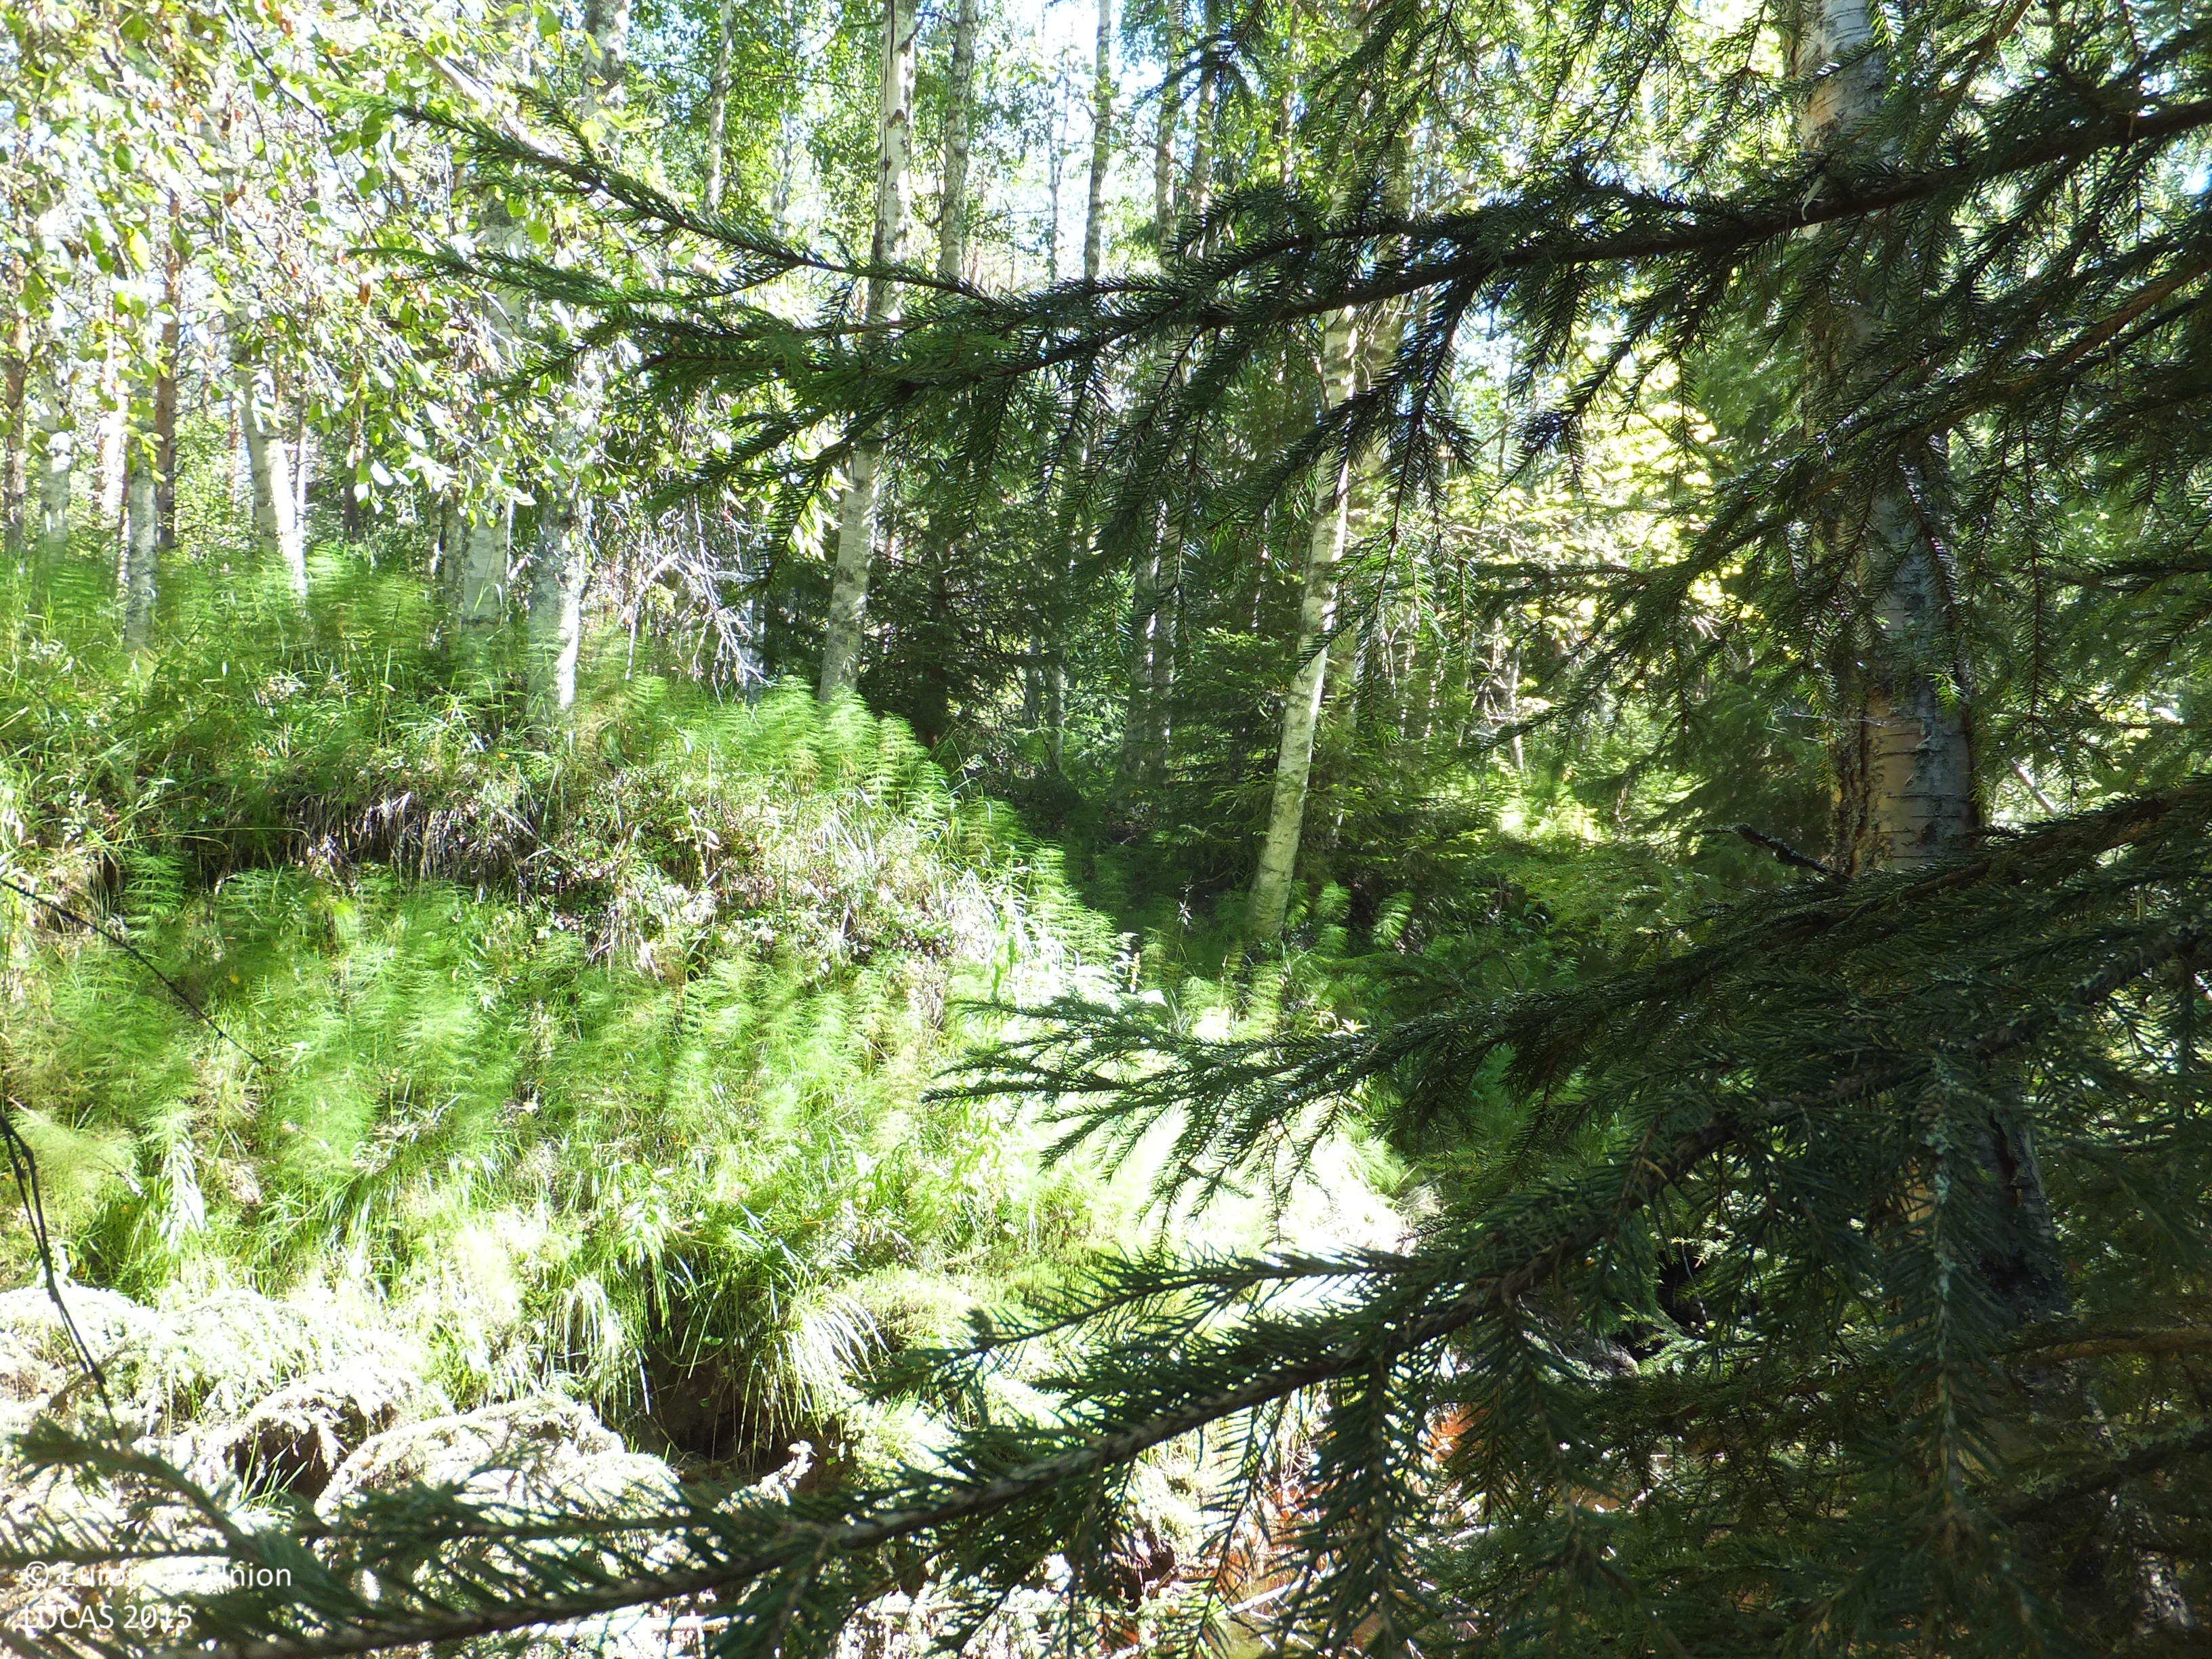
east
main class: Woodland
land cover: Spruce dominated mixed woodland
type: boreal forest
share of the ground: > 75 %
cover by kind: coniferous forest trees 40 %, broadleaved forest trees 40 %, herbaceous plants 10 %, lichens and mosses 5 %, unconsolidated bare surface 5 %
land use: Forestry
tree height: > 5 m
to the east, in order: Spruce dominated mixed woodland; Rivers and streams; Pine dominated mixed woodland; Ditches and canals; Pine dominated mixed woodland; Ditches and canals; Pine dominated mixed woodland; Ditches and canals; Pine dominated mixed woodland; Ditches and canals; Pine dominated mixed woodland
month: August
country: FI
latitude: 63.1138
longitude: 23.3631
